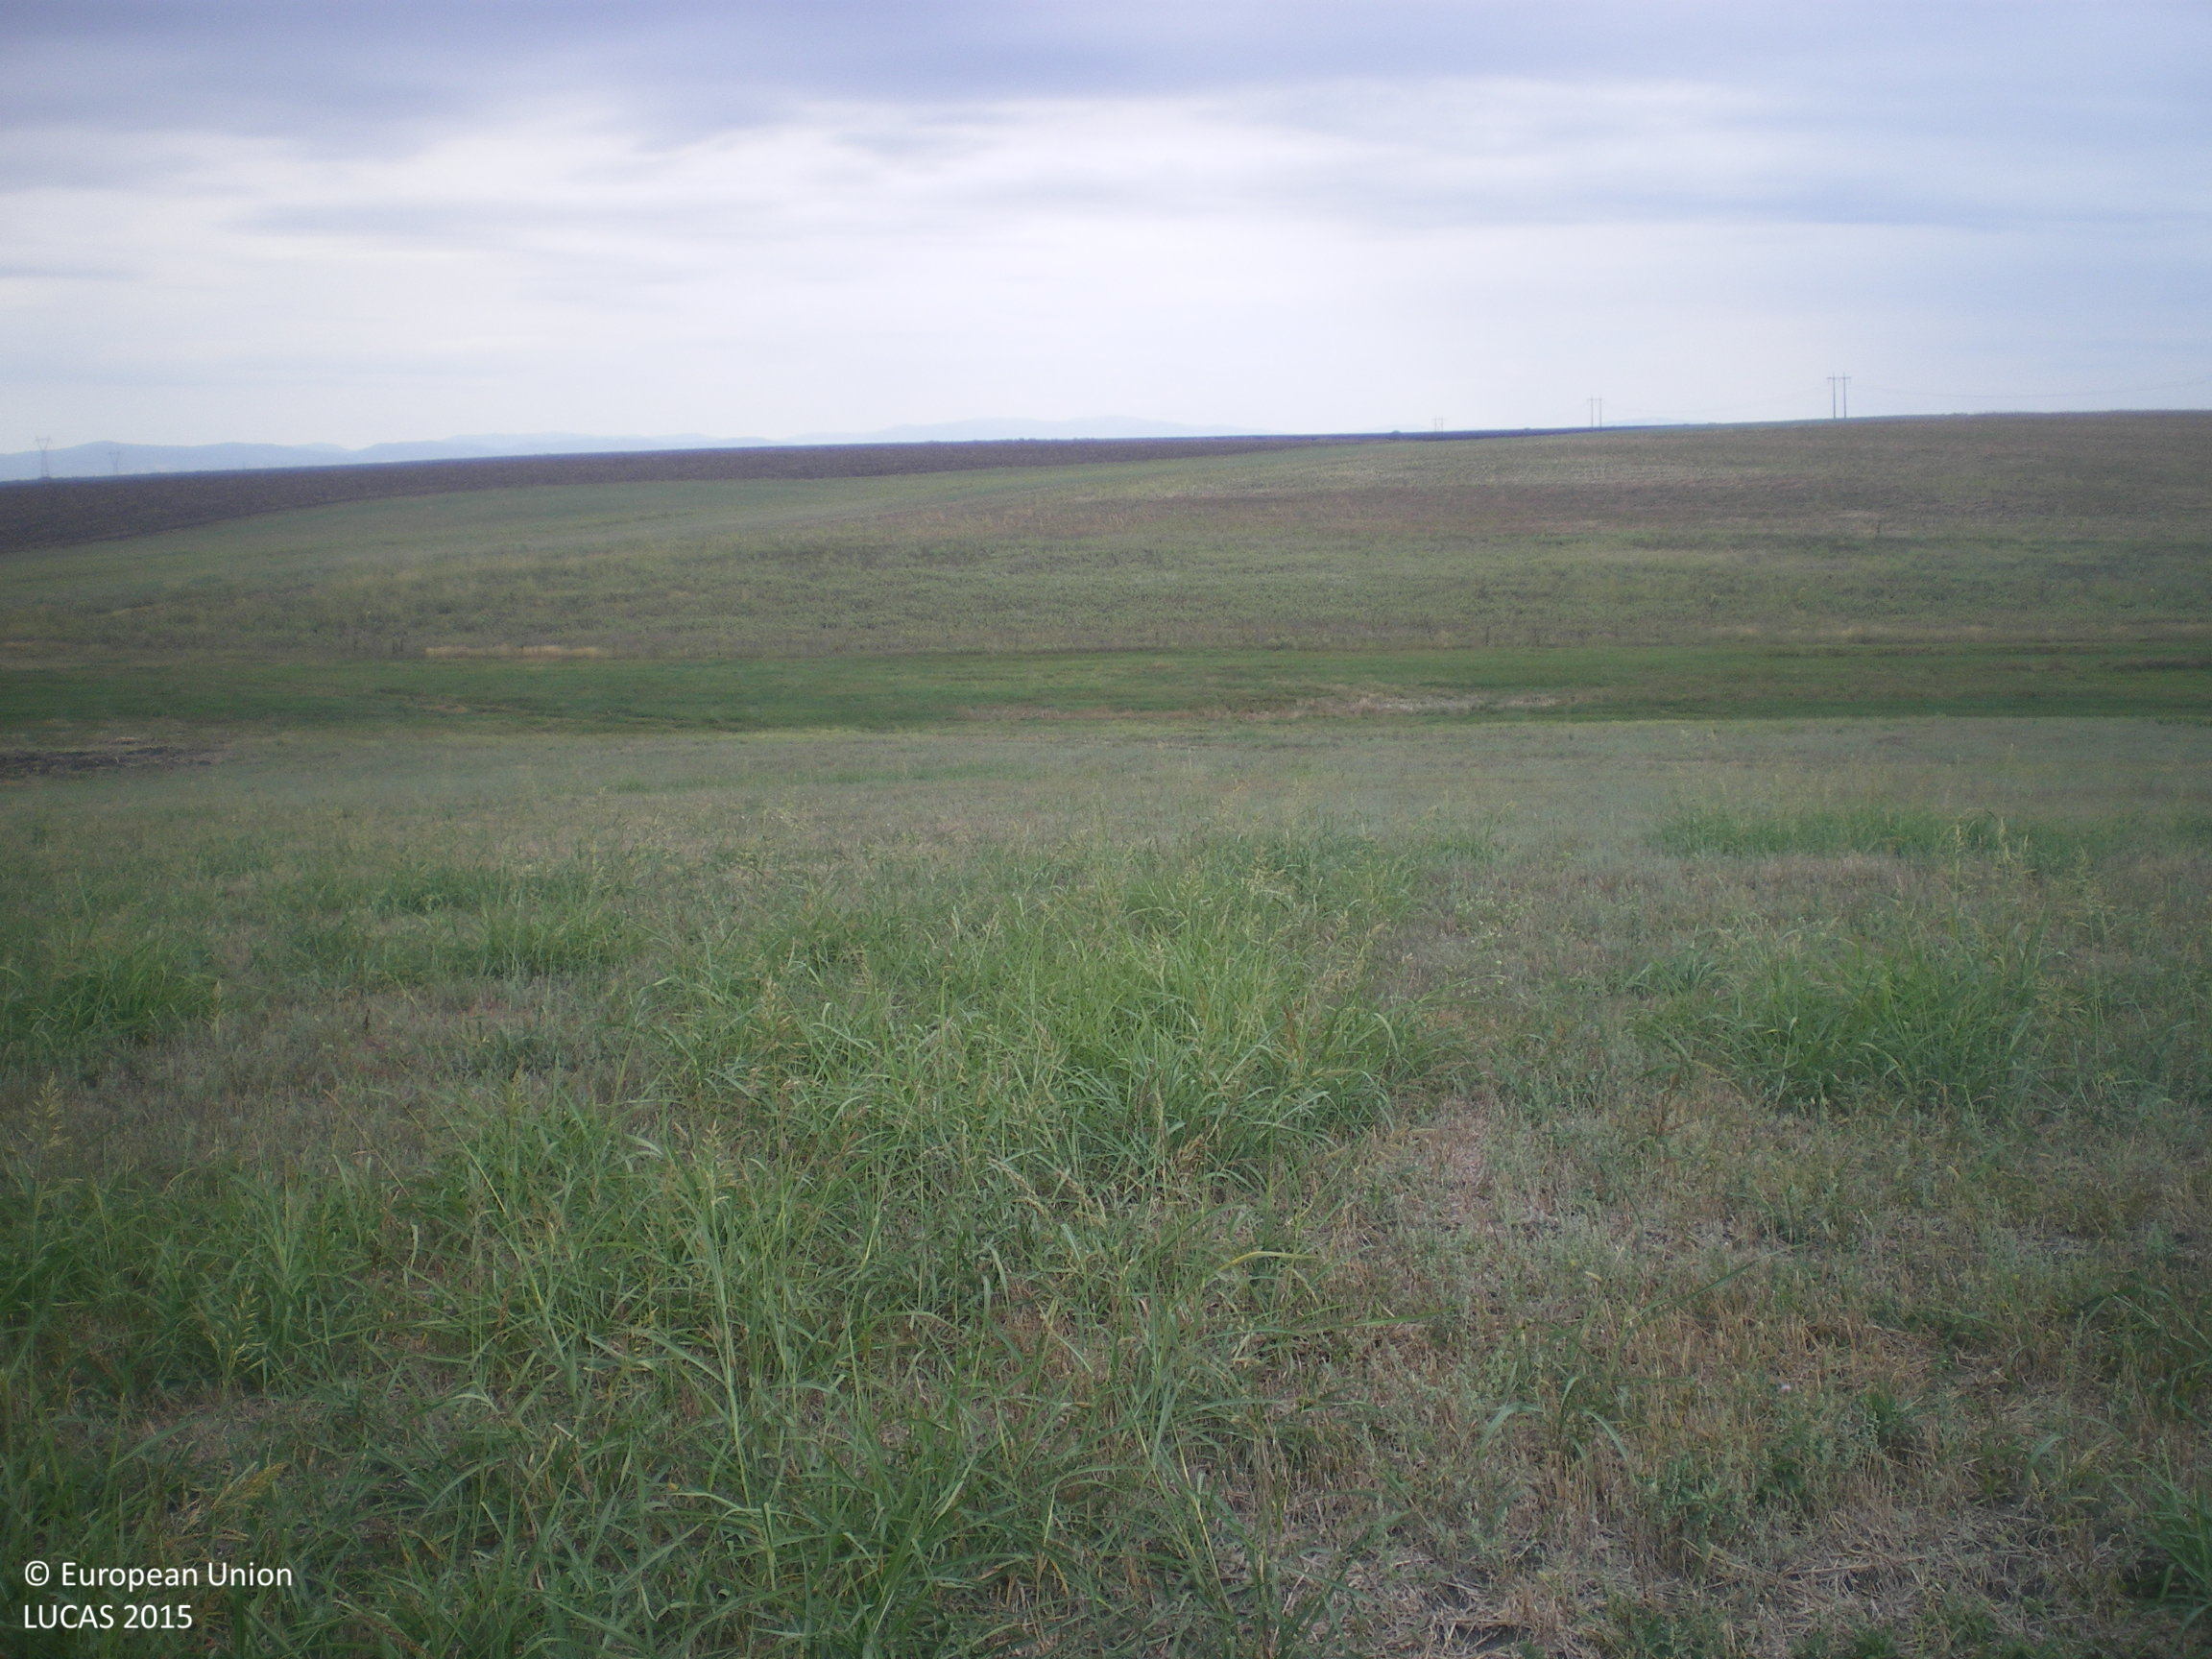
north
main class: Cropland
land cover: Rye
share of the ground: 10 - 25 %
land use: Agriculture (excluding fallow land and kitchen gardens)
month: September
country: BG
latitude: 42.2255
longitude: 25.8363
